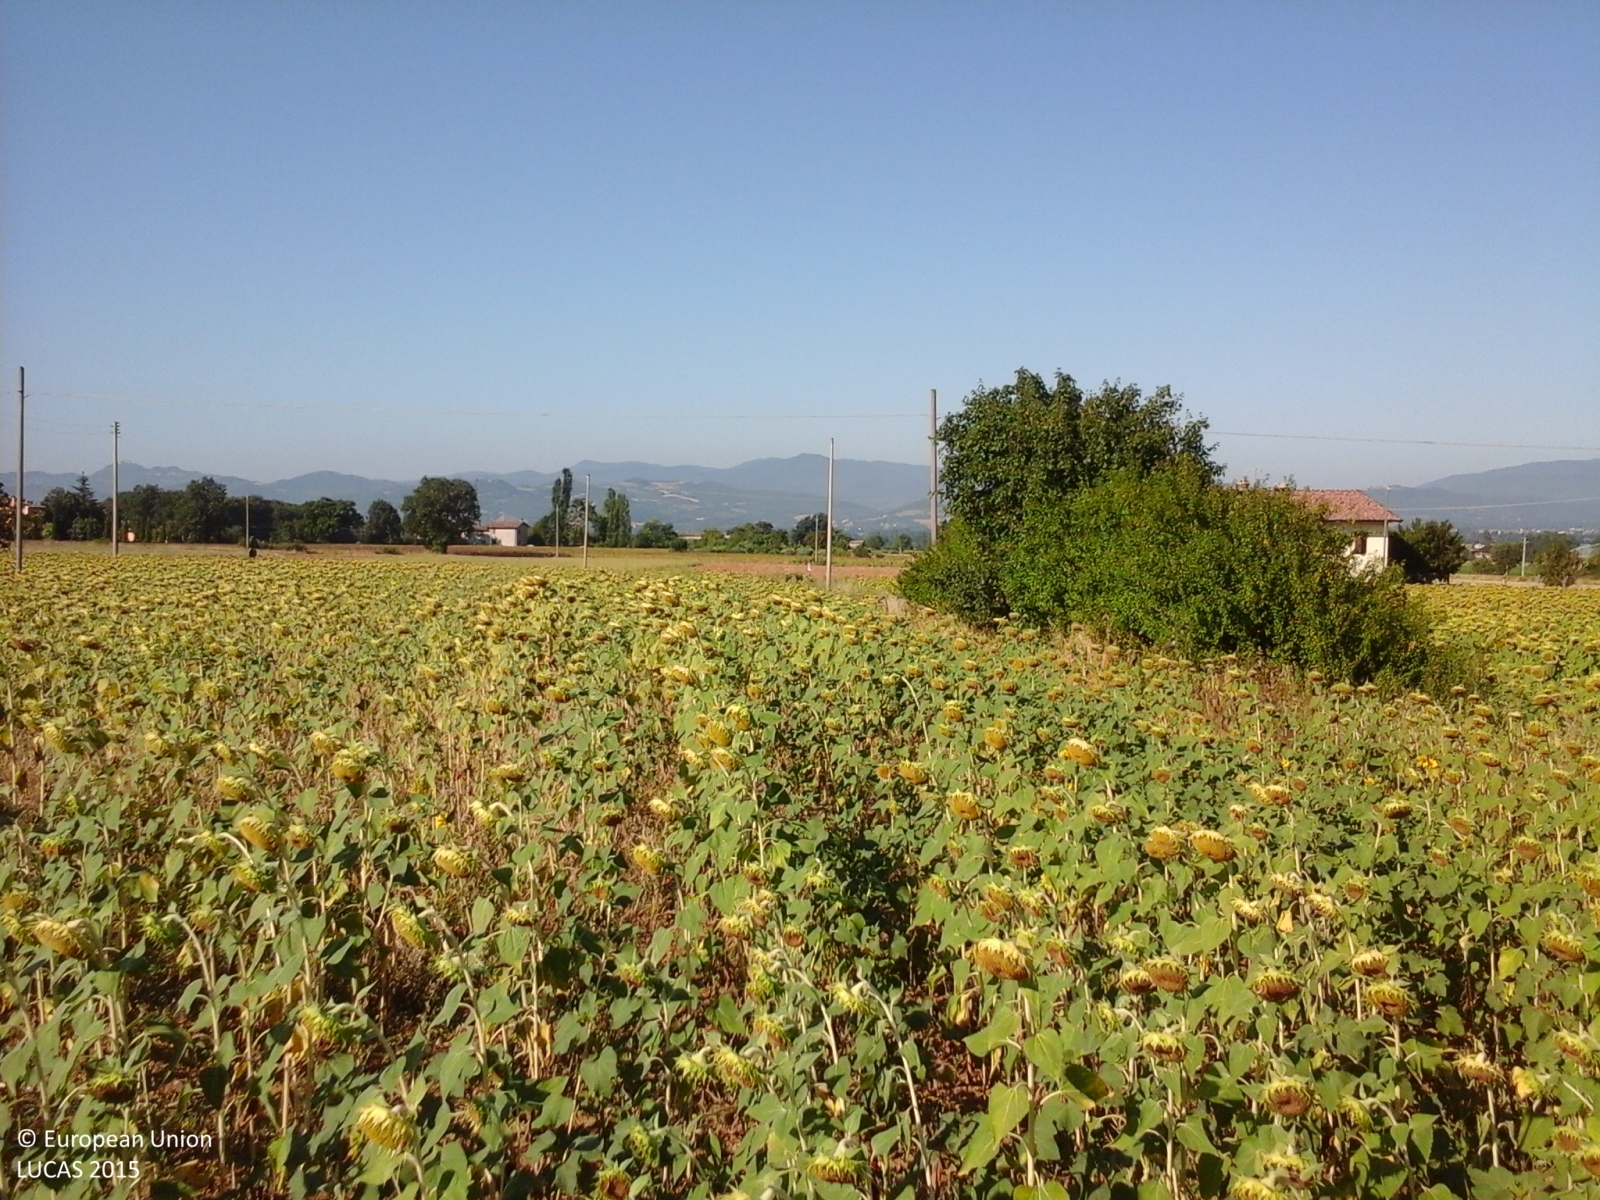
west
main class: Cropland
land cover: Sunflower
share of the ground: > 75 %
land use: Agriculture (excluding fallow land and kitchen gardens)
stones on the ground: < 10 %
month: August
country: IT
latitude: 43.5329
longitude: 12.2091
